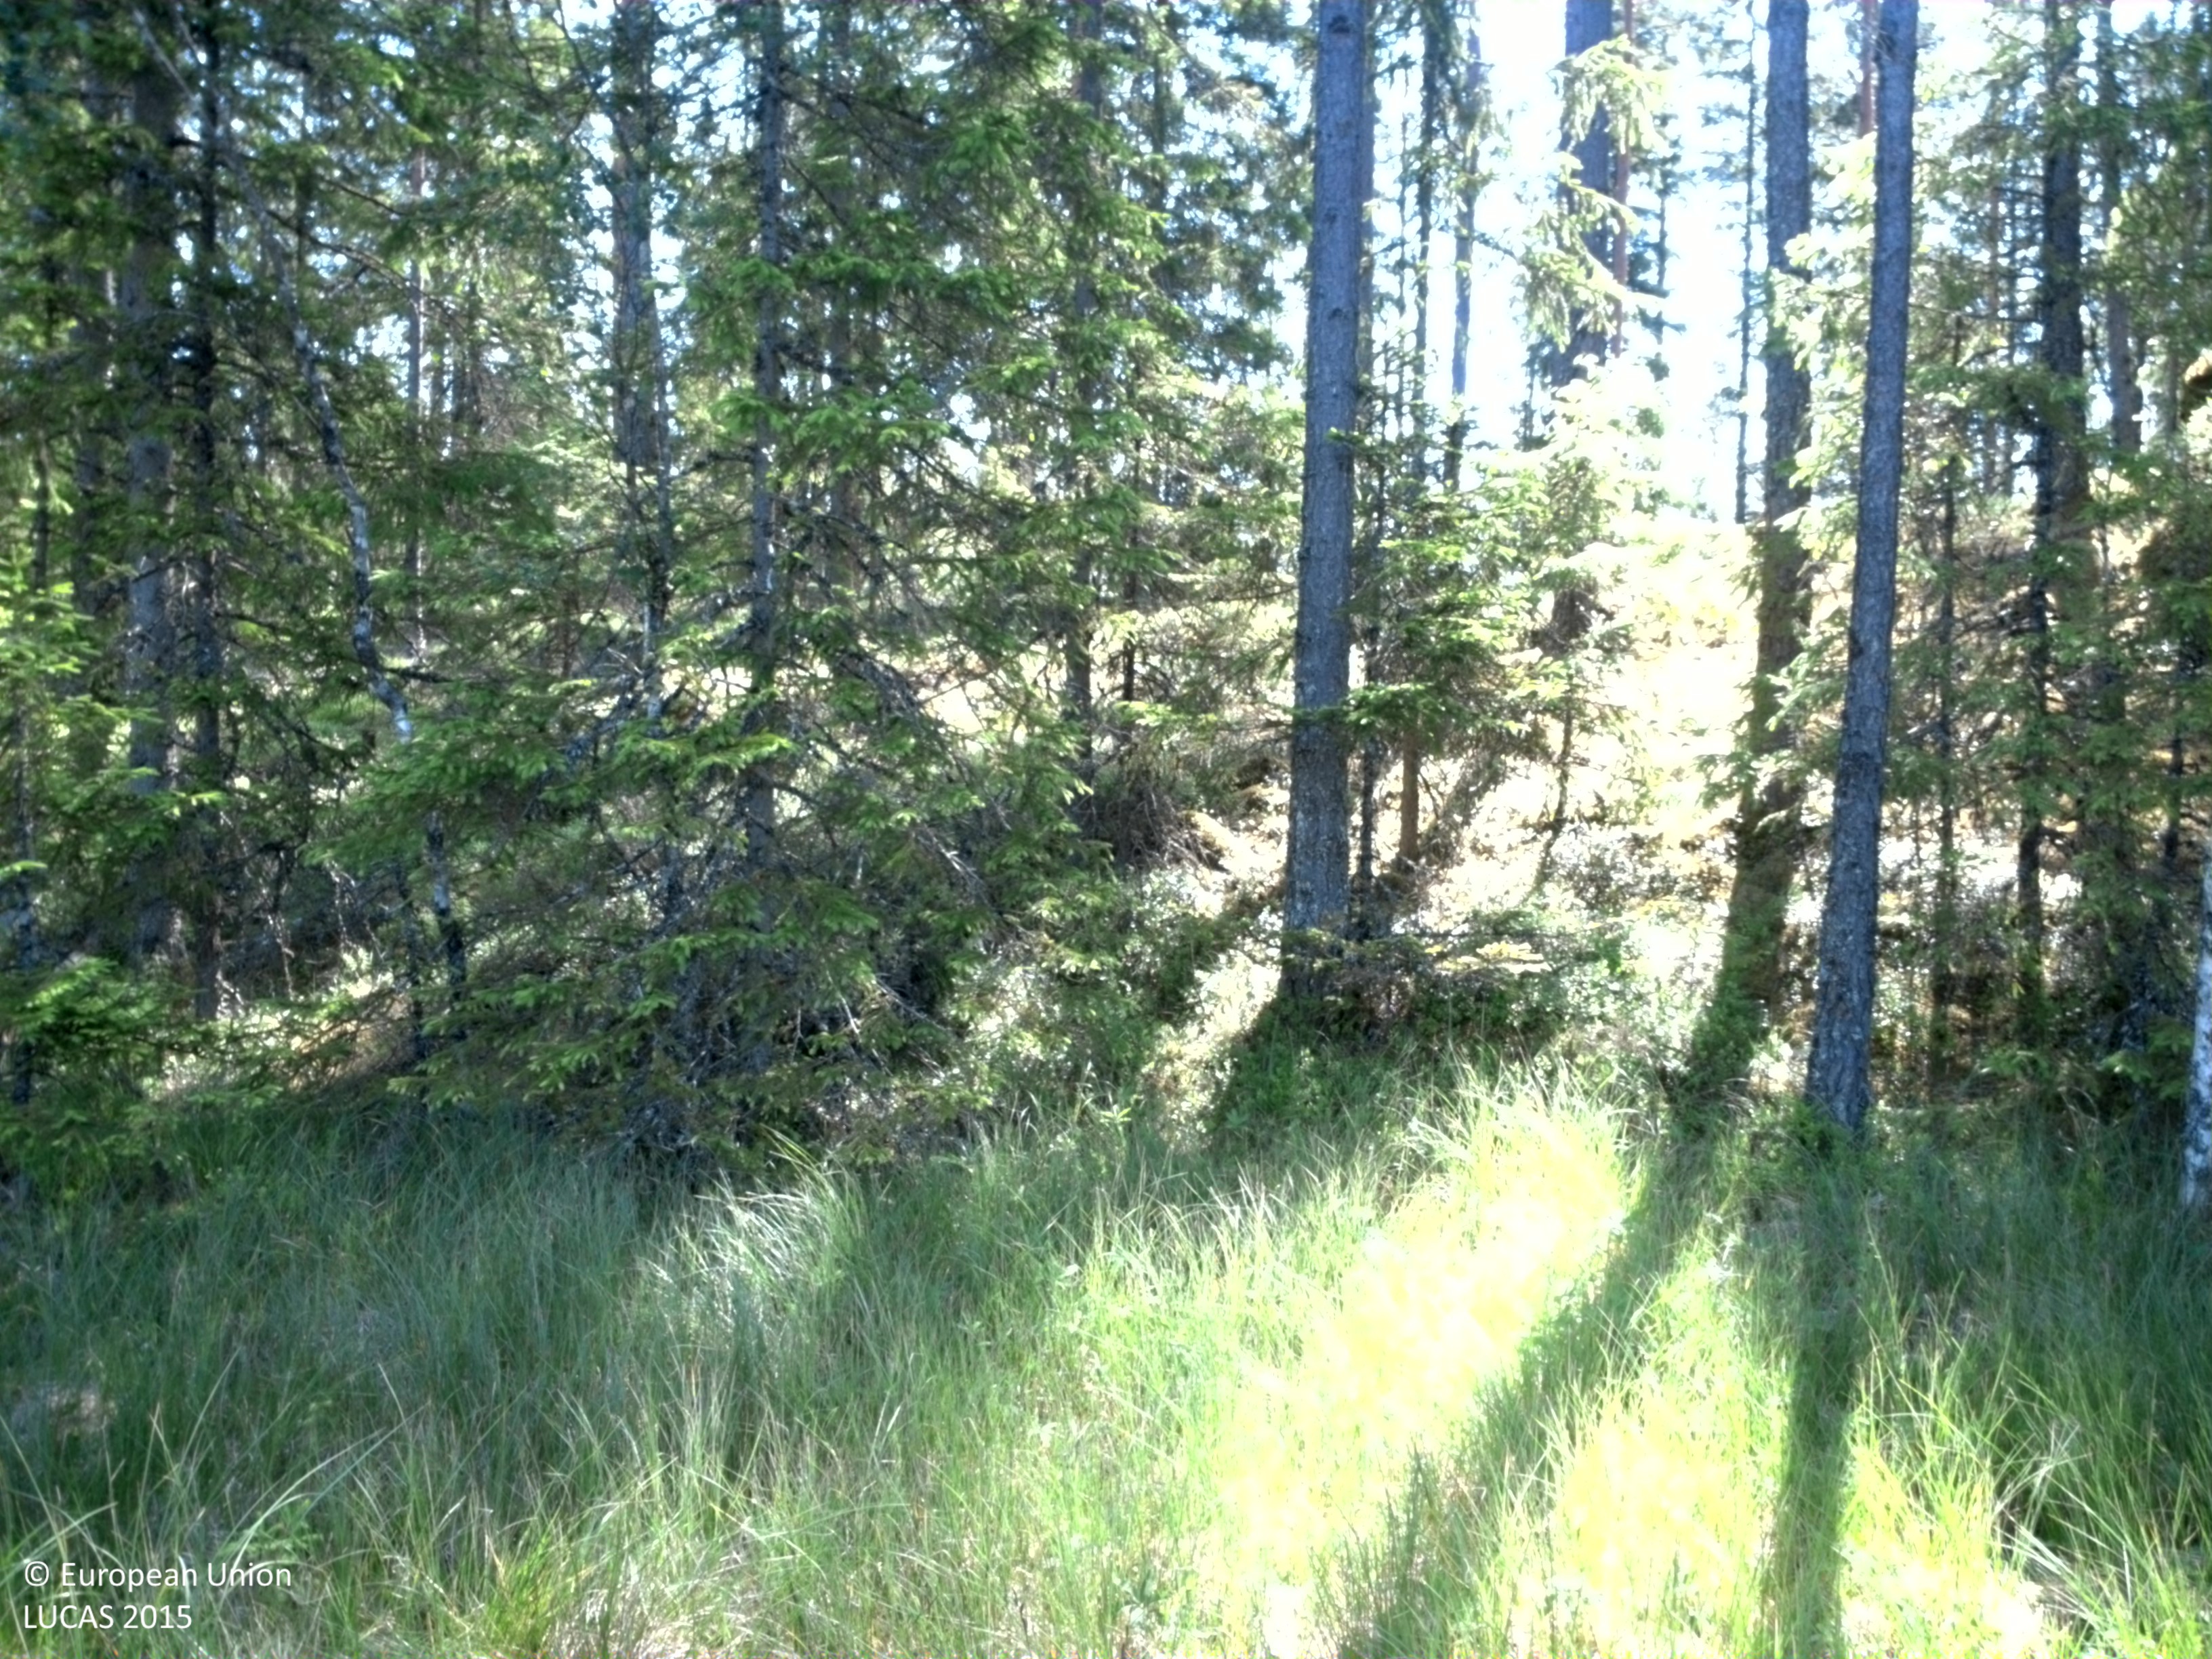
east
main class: Woodland
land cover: Pine dominated coniferous woodland
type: boreal forest
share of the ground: 10 - 25 %
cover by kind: lichens and mosses 45 %, coniferous forest trees 20 %, herbaceous plants 20 %, shrubs 10 %, broadleaved forest trees 5 %
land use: Forestry
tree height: > 5 m
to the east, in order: Pine dominated coniferous woodland; Tracks; Pine dominated coniferous woodland; Tracks; Pine dominated coniferous woodland; Spruce dominated coniferous woodland; Pine dominated coniferous woodland; Spruce dominated coniferous woodland; Pine dominated coniferous woodland
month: July
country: SE
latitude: 57.6238
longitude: 13.8631
